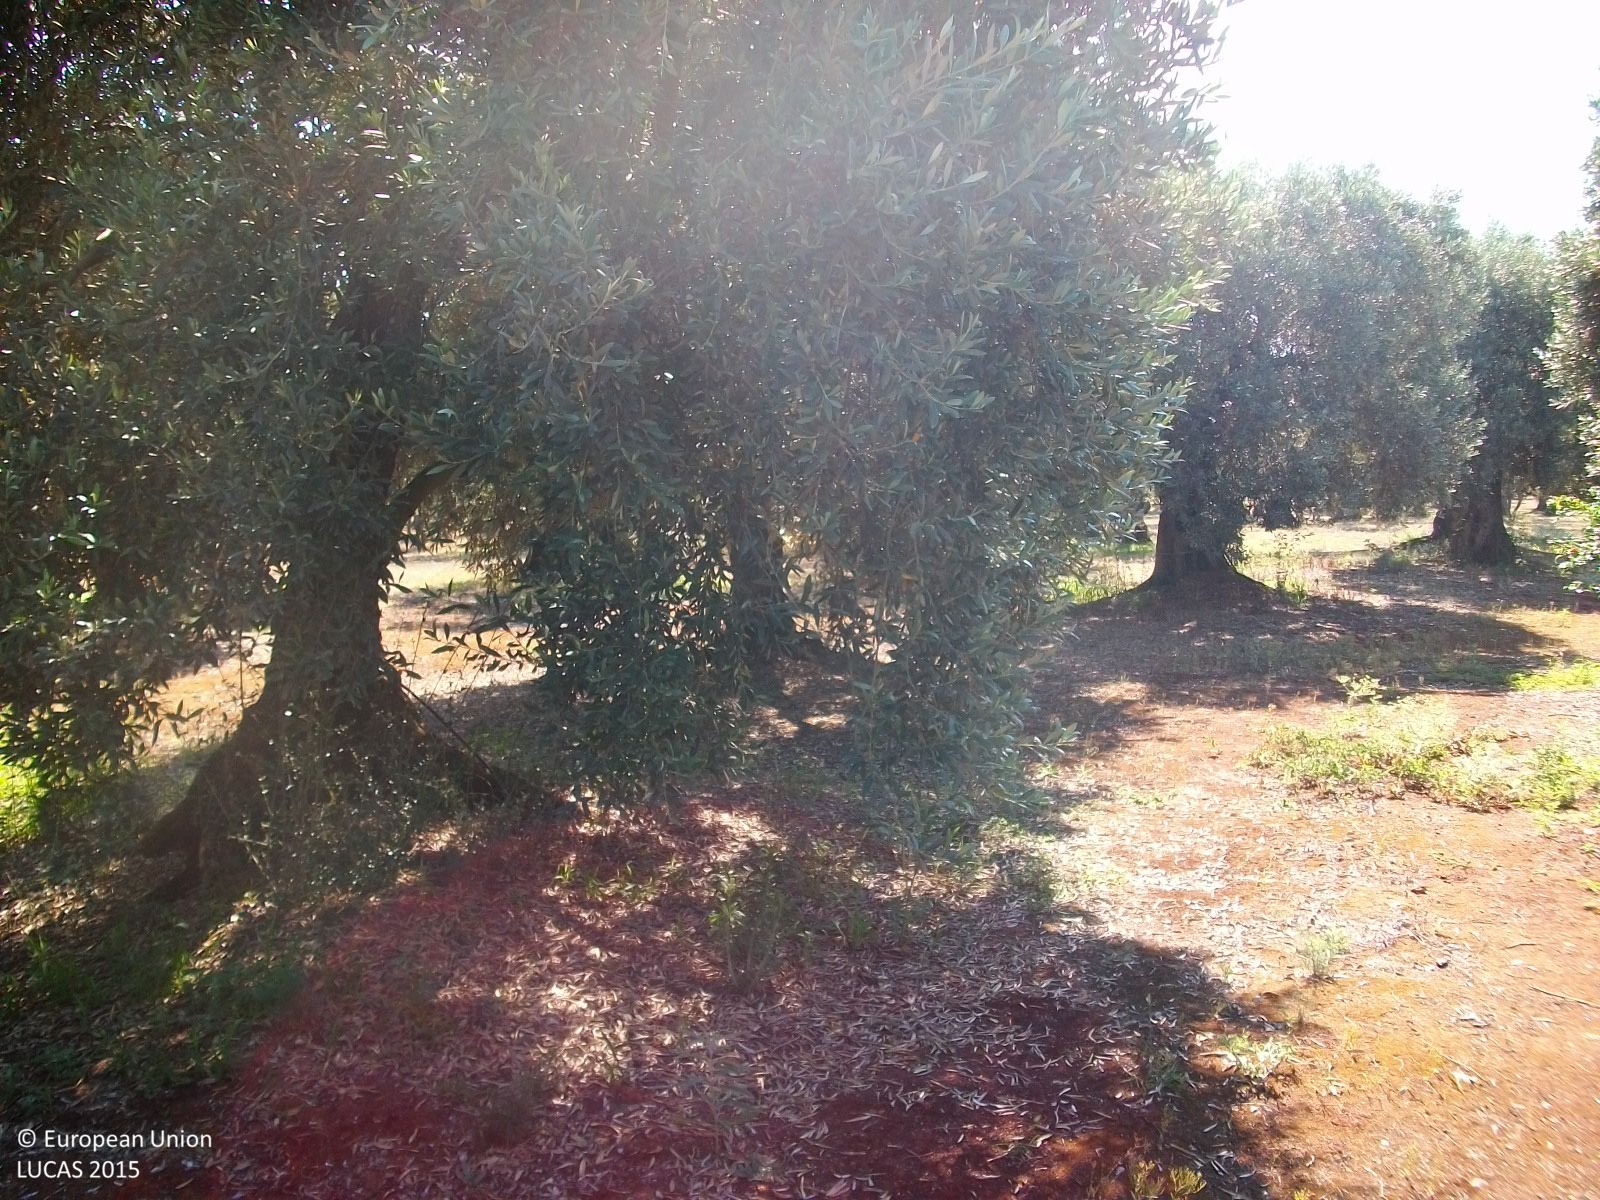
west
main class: Cropland
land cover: Olive groves
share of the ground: > 75 %
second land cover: Spontaneously vegetated surfaces
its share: 25 - 50 %
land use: Agriculture (excluding fallow land and kitchen gardens)
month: June
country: GR
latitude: 38.9163
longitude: 22.6345
